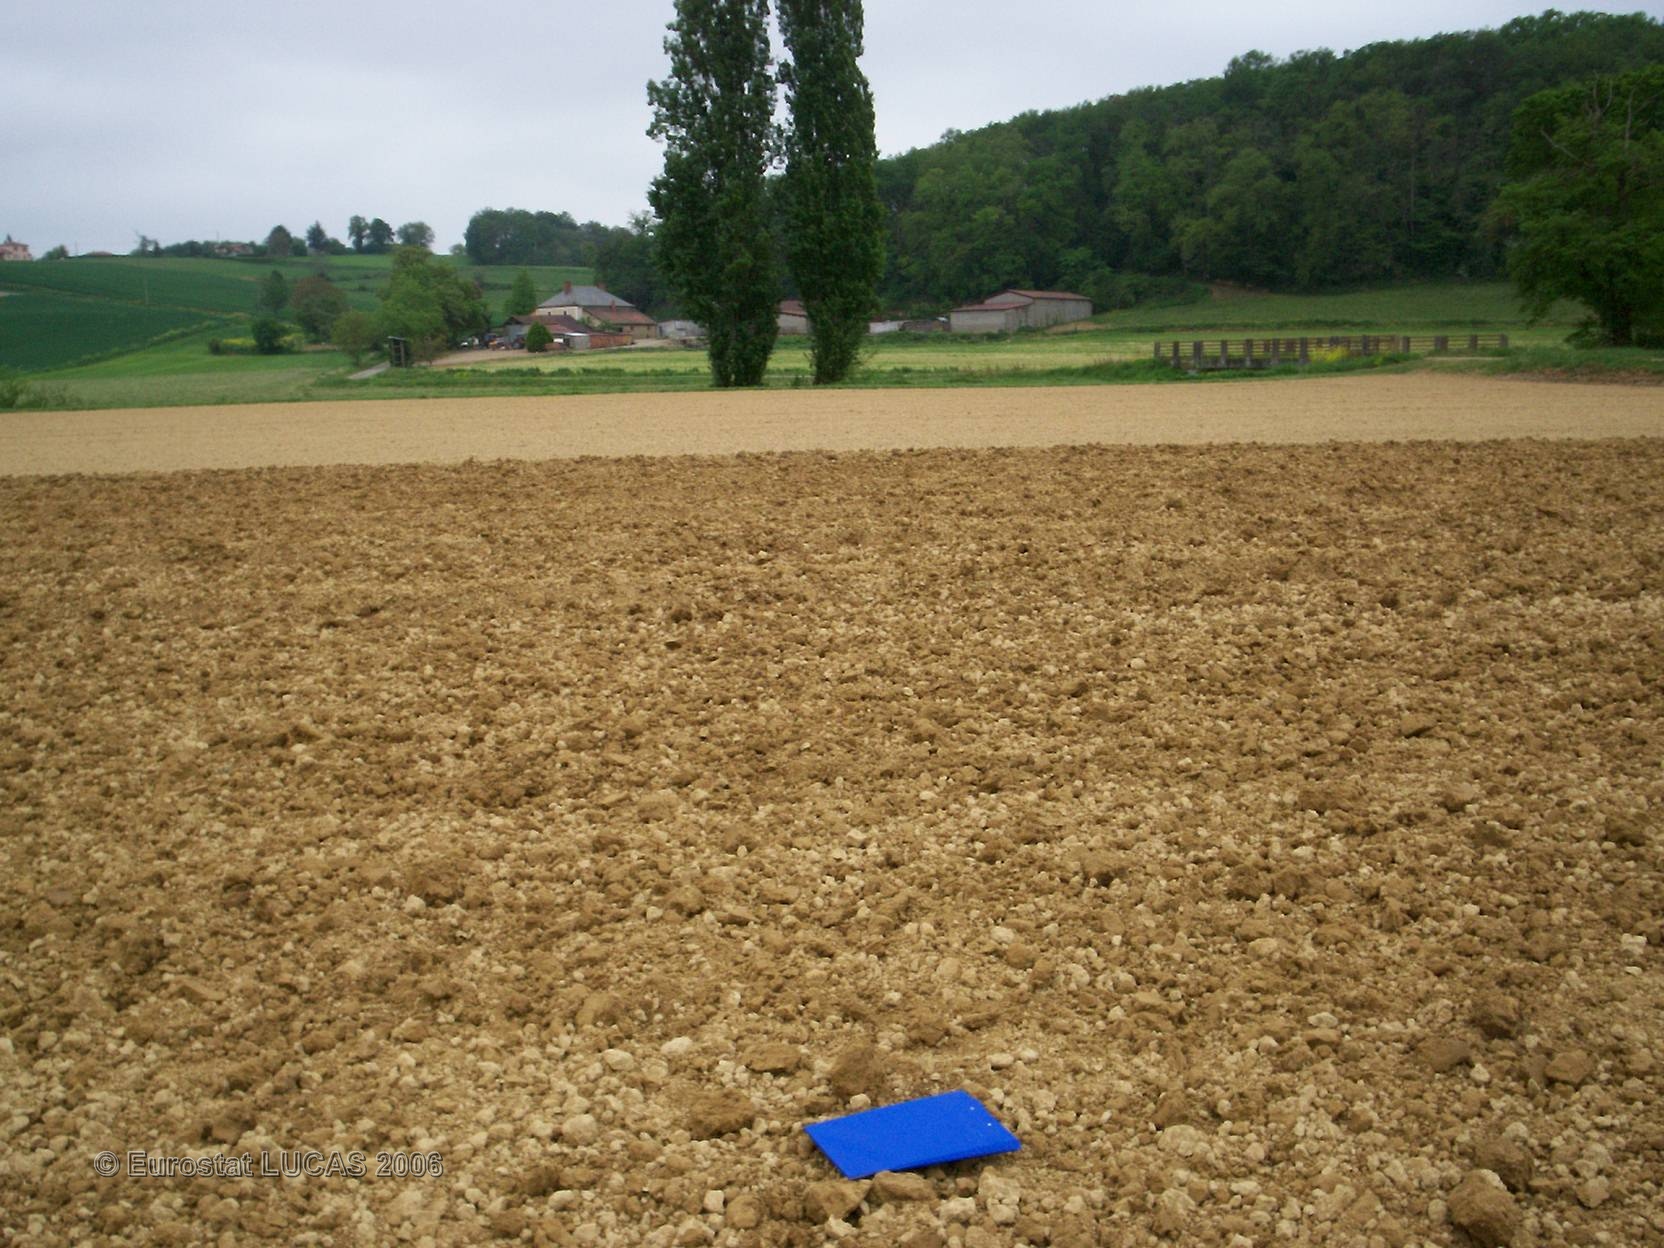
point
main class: Cropland
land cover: Maize
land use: Agriculture (excluding fallow land and kitchen gardens)
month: May
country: FR
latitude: 43.6254
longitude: -0.2323
